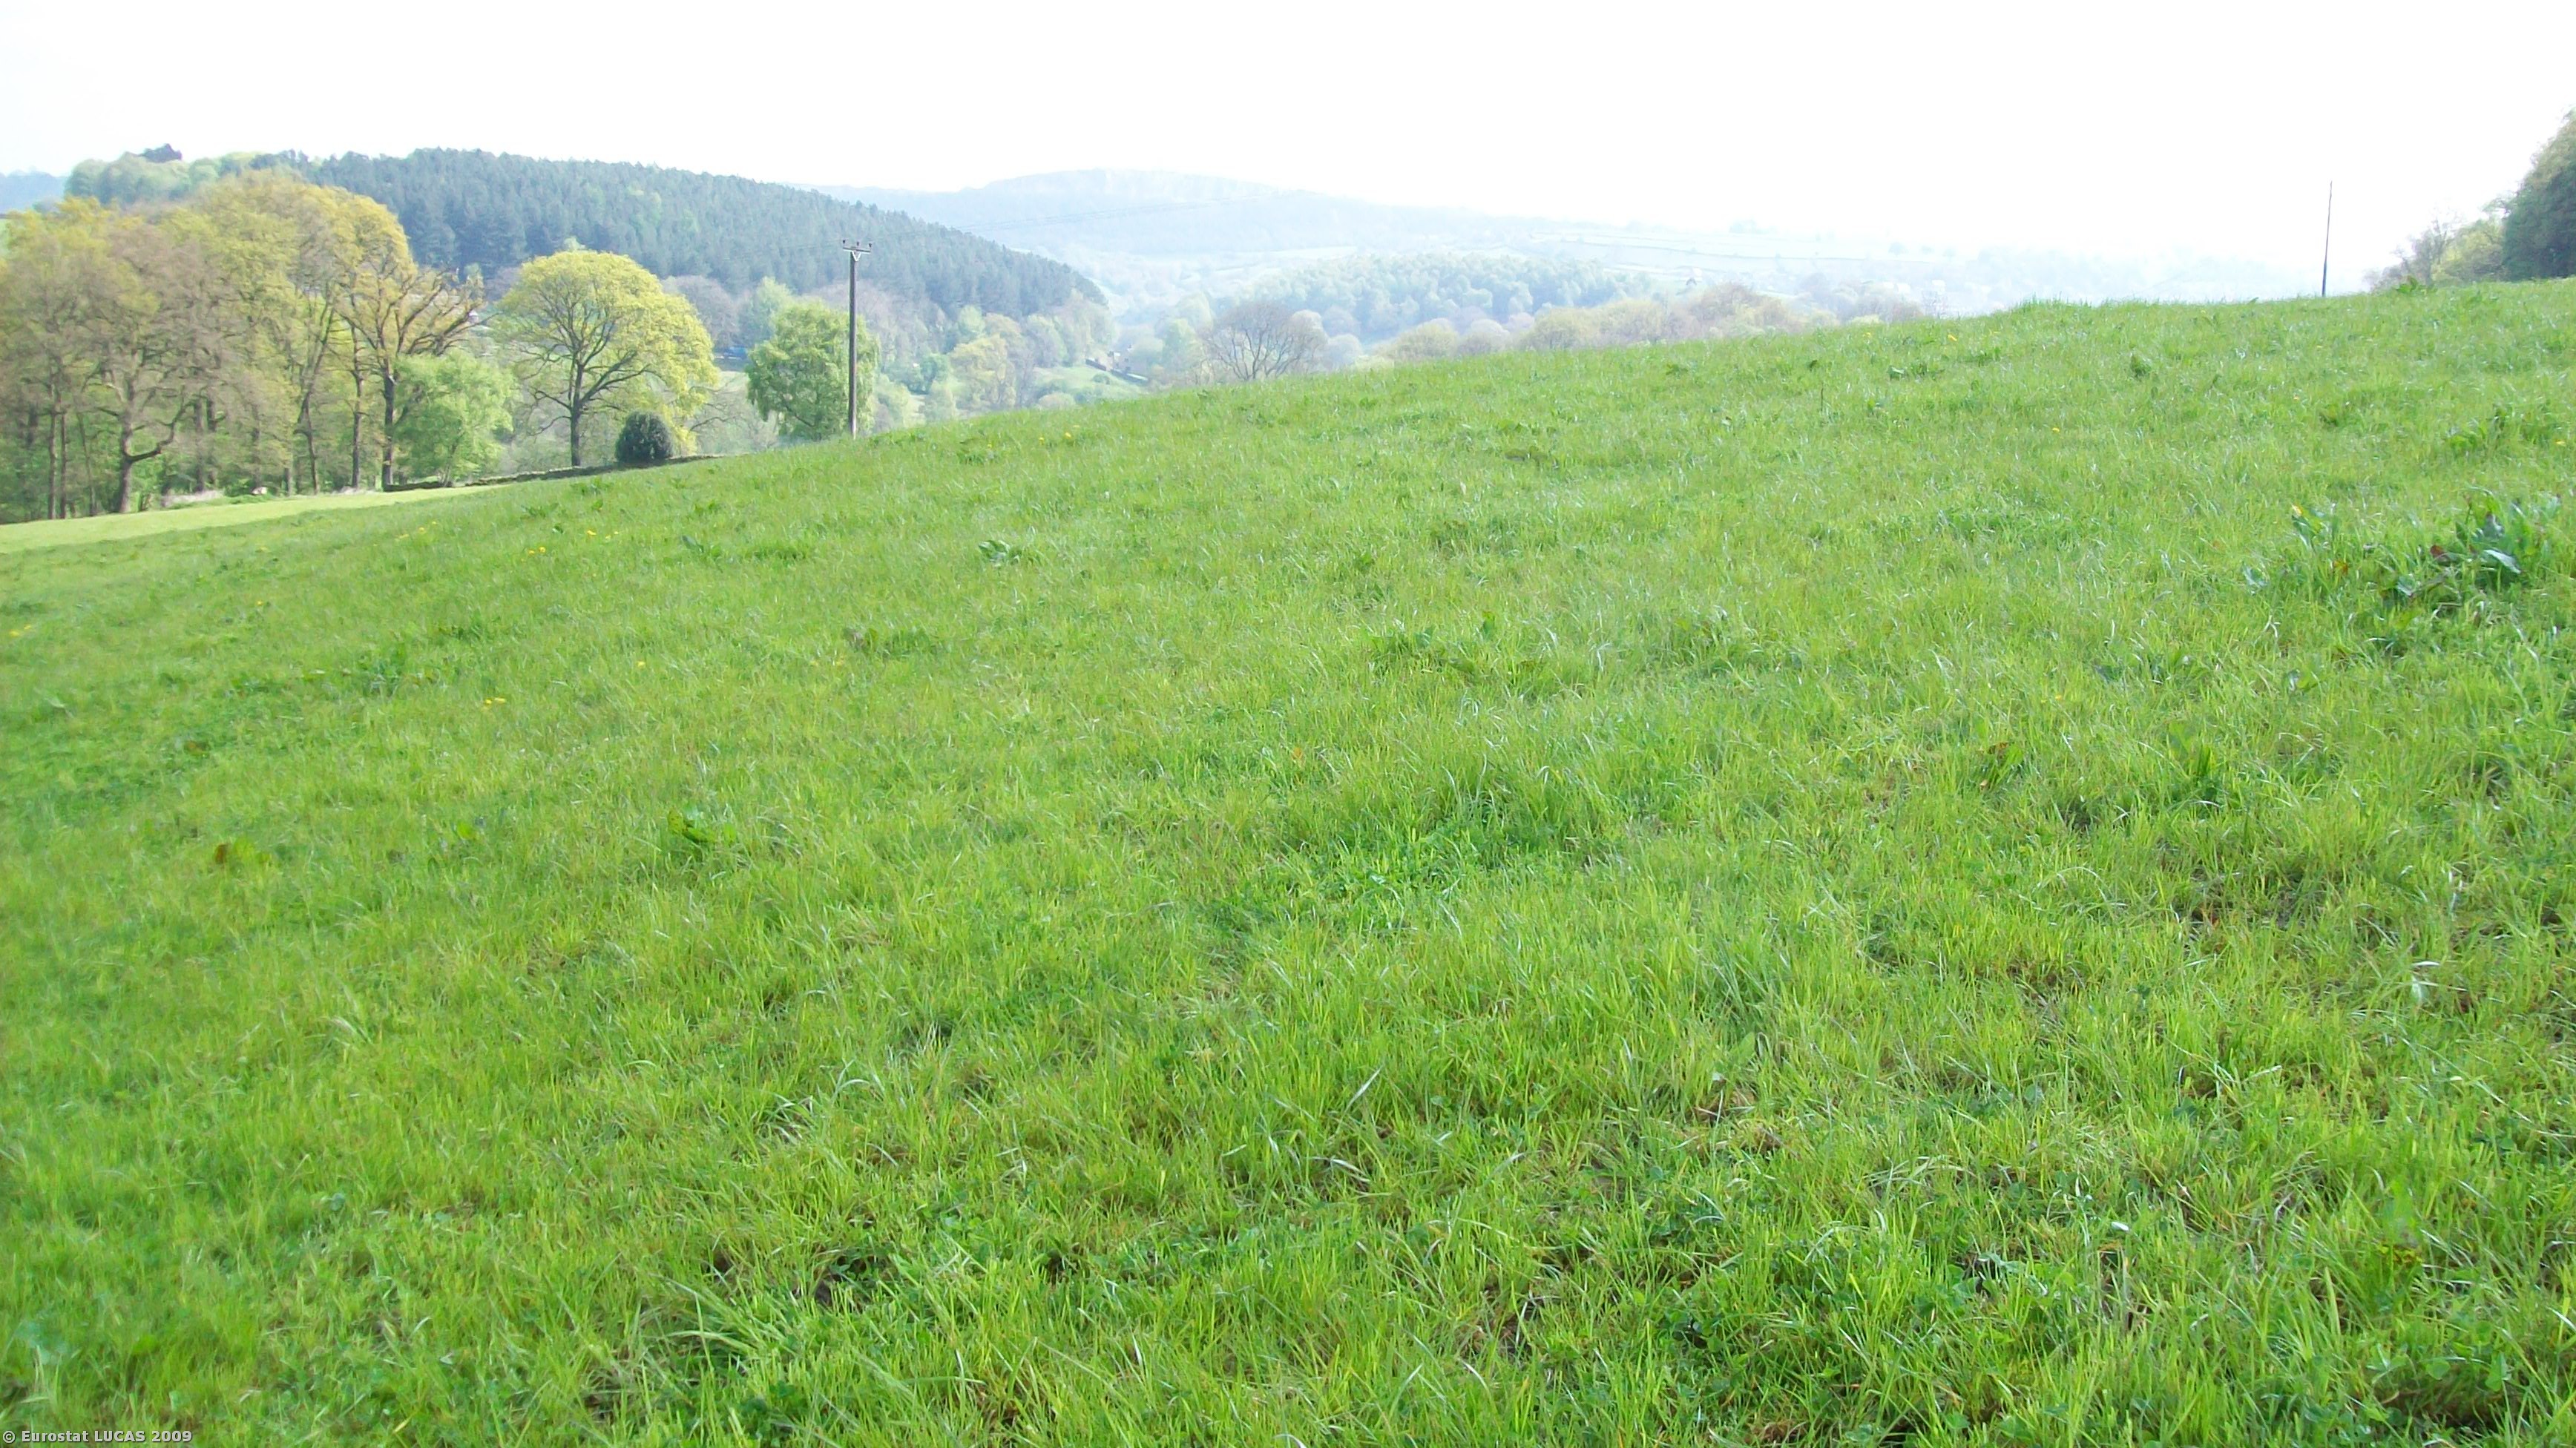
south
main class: Grassland
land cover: Grassland without tree/shrub cover
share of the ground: > 75 %
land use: Agriculture (excluding fallow land and kitchen gardens)
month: April
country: GB
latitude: 53.0851
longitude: -1.5321
